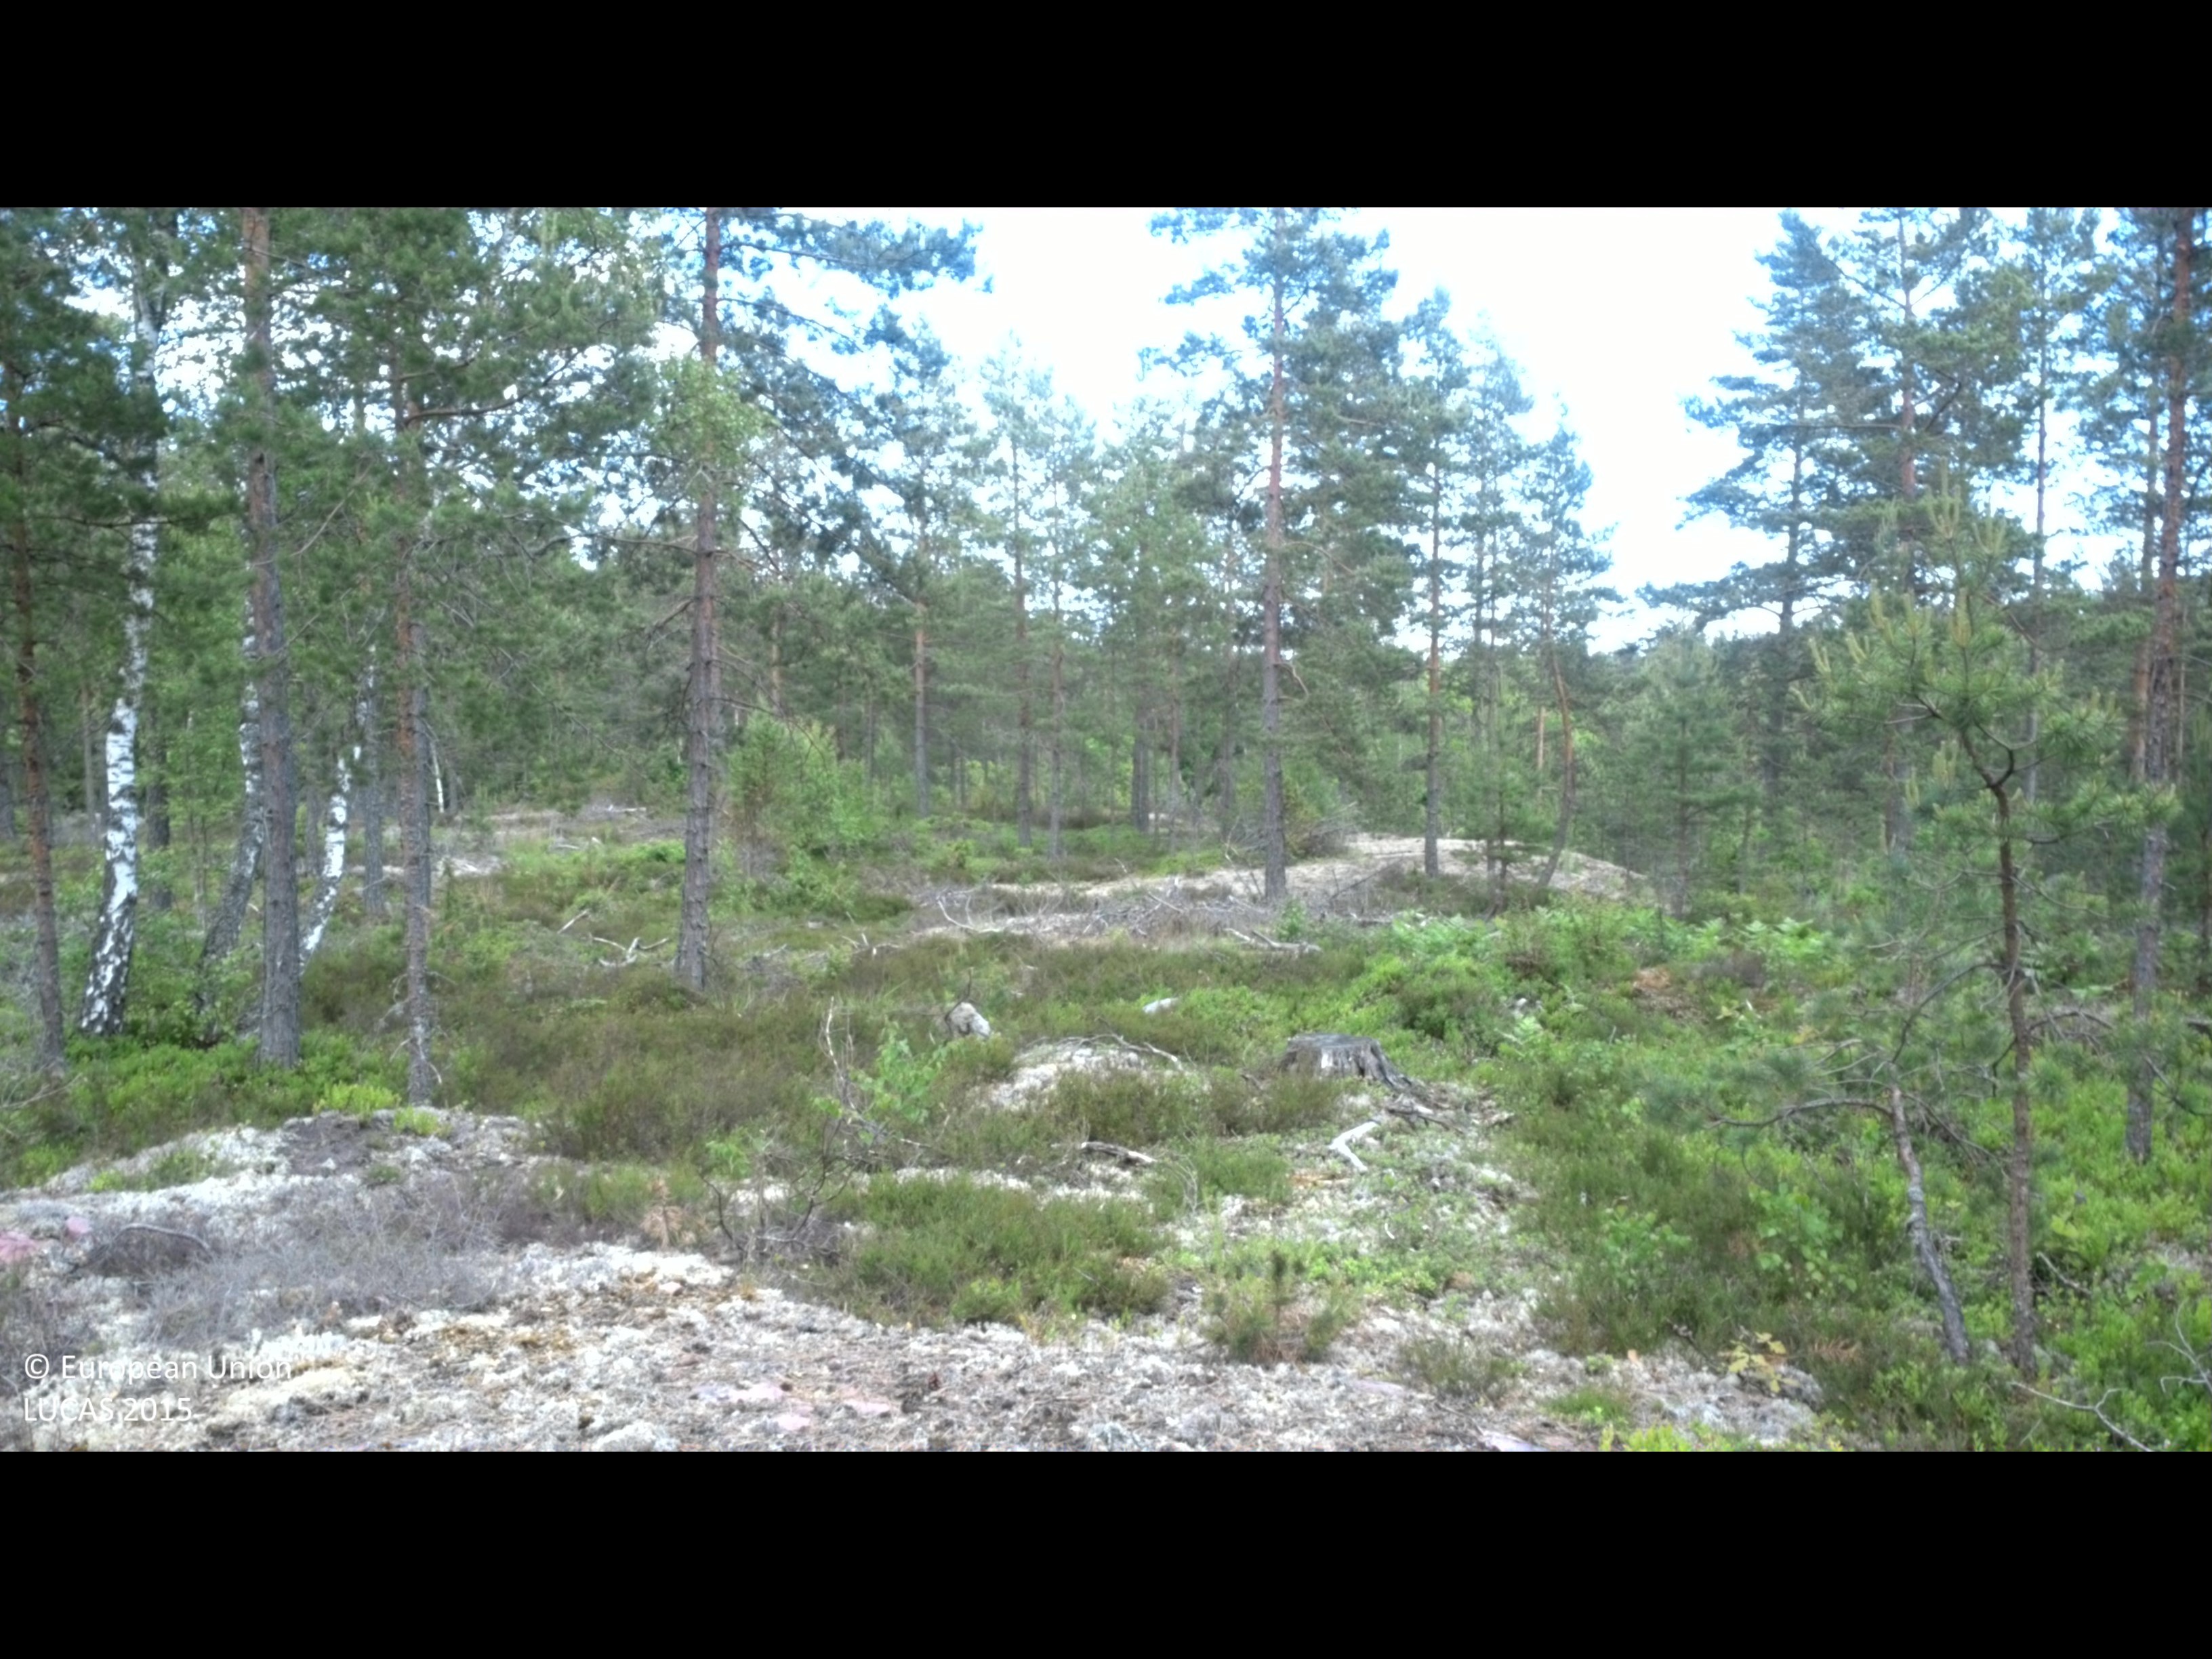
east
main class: Woodland
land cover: Pine dominated coniferous woodland
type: boreal forest
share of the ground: 25 - 50 %
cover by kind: coniferous forest trees 40 %, shrubs 40 %, lichens and mosses 10 %, broadleaved forest trees 5 %, herbaceous plants 5 %
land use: Forestry
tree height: > 5 m
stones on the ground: < 10 %
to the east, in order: Pine dominated coniferous woodland; Other mixed woodland; Broadleaved woodland; Grass margins; Abandoned hedges; Rocks and stones; Shrubland with sparse tree cover; Broadleaved woodland; Artificial constructions in urban areas
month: June
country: SE
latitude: 57.6788
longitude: 16.5893
